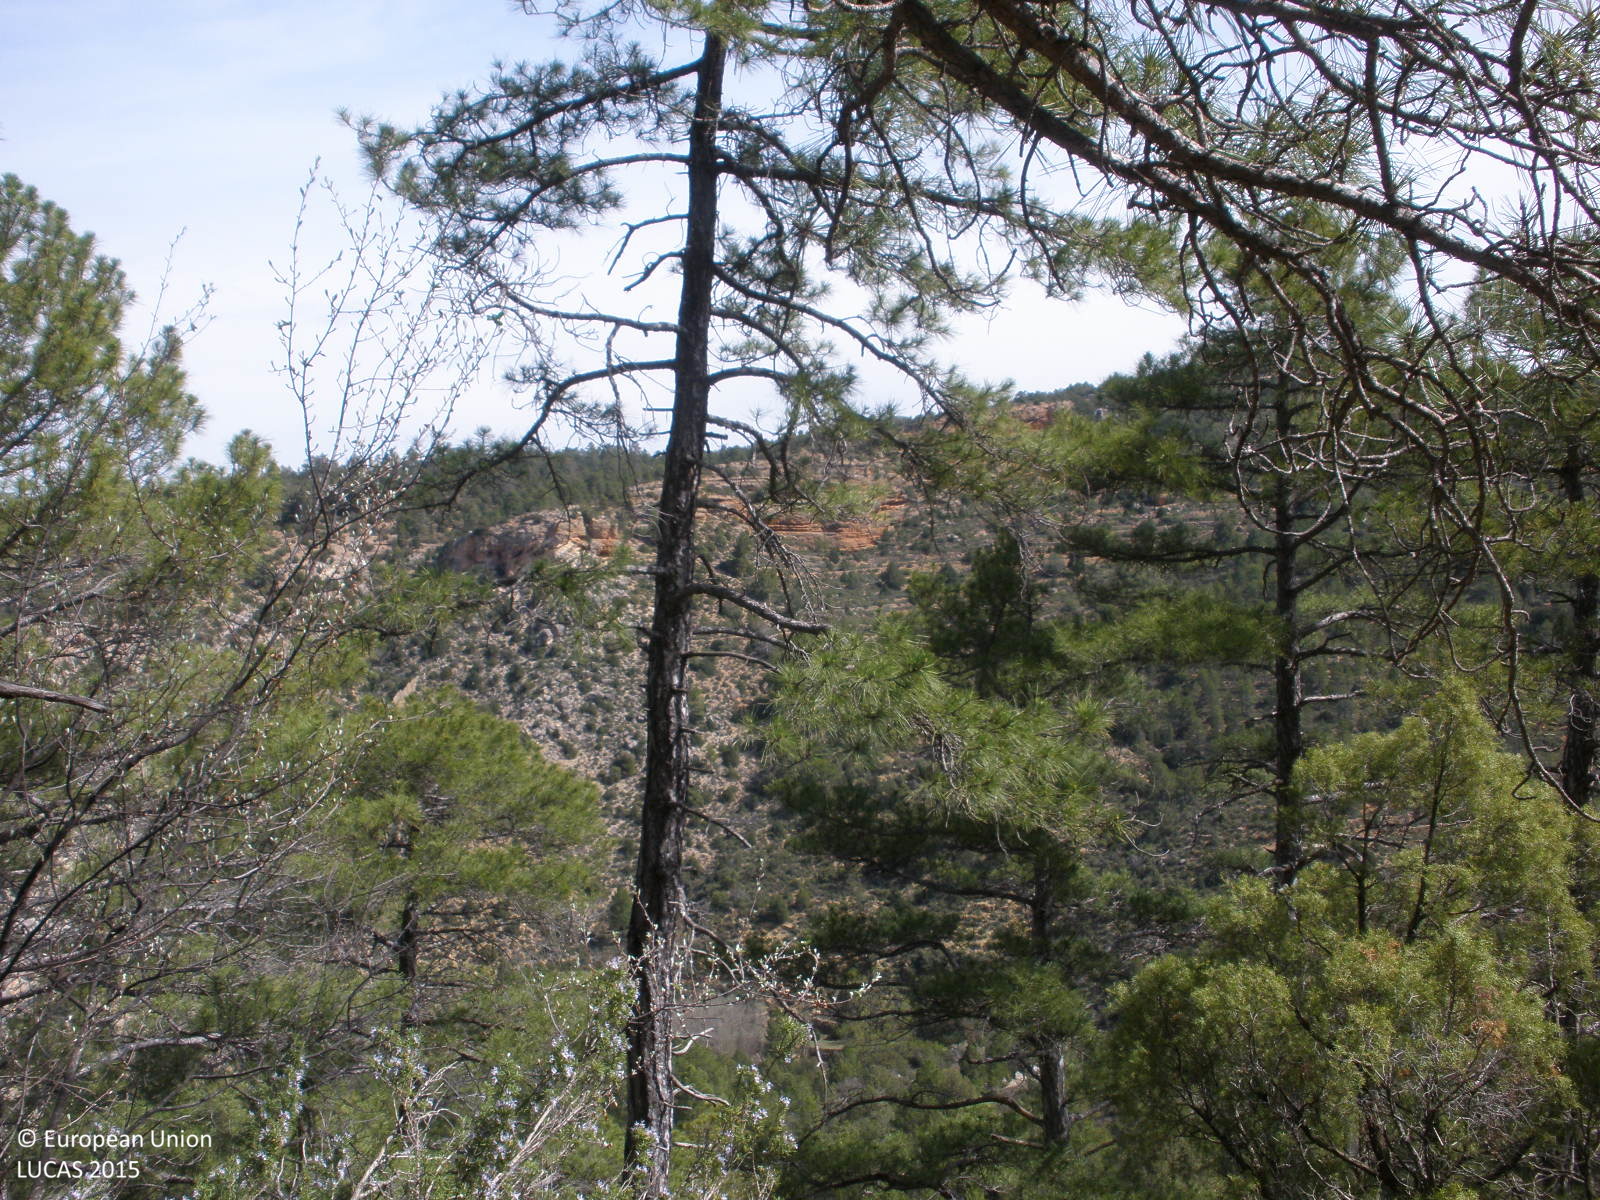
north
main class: Woodland
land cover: Pine dominated coniferous woodland
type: coniferous forest of the mediterranean region
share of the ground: > 75 %
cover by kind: coniferous forest trees 70 %, shrubs 30 %
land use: Semi-natural and natural areas not in use
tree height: > 5 m
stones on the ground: > 50 %
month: April
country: ES
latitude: 40.0461
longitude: -1.1782
